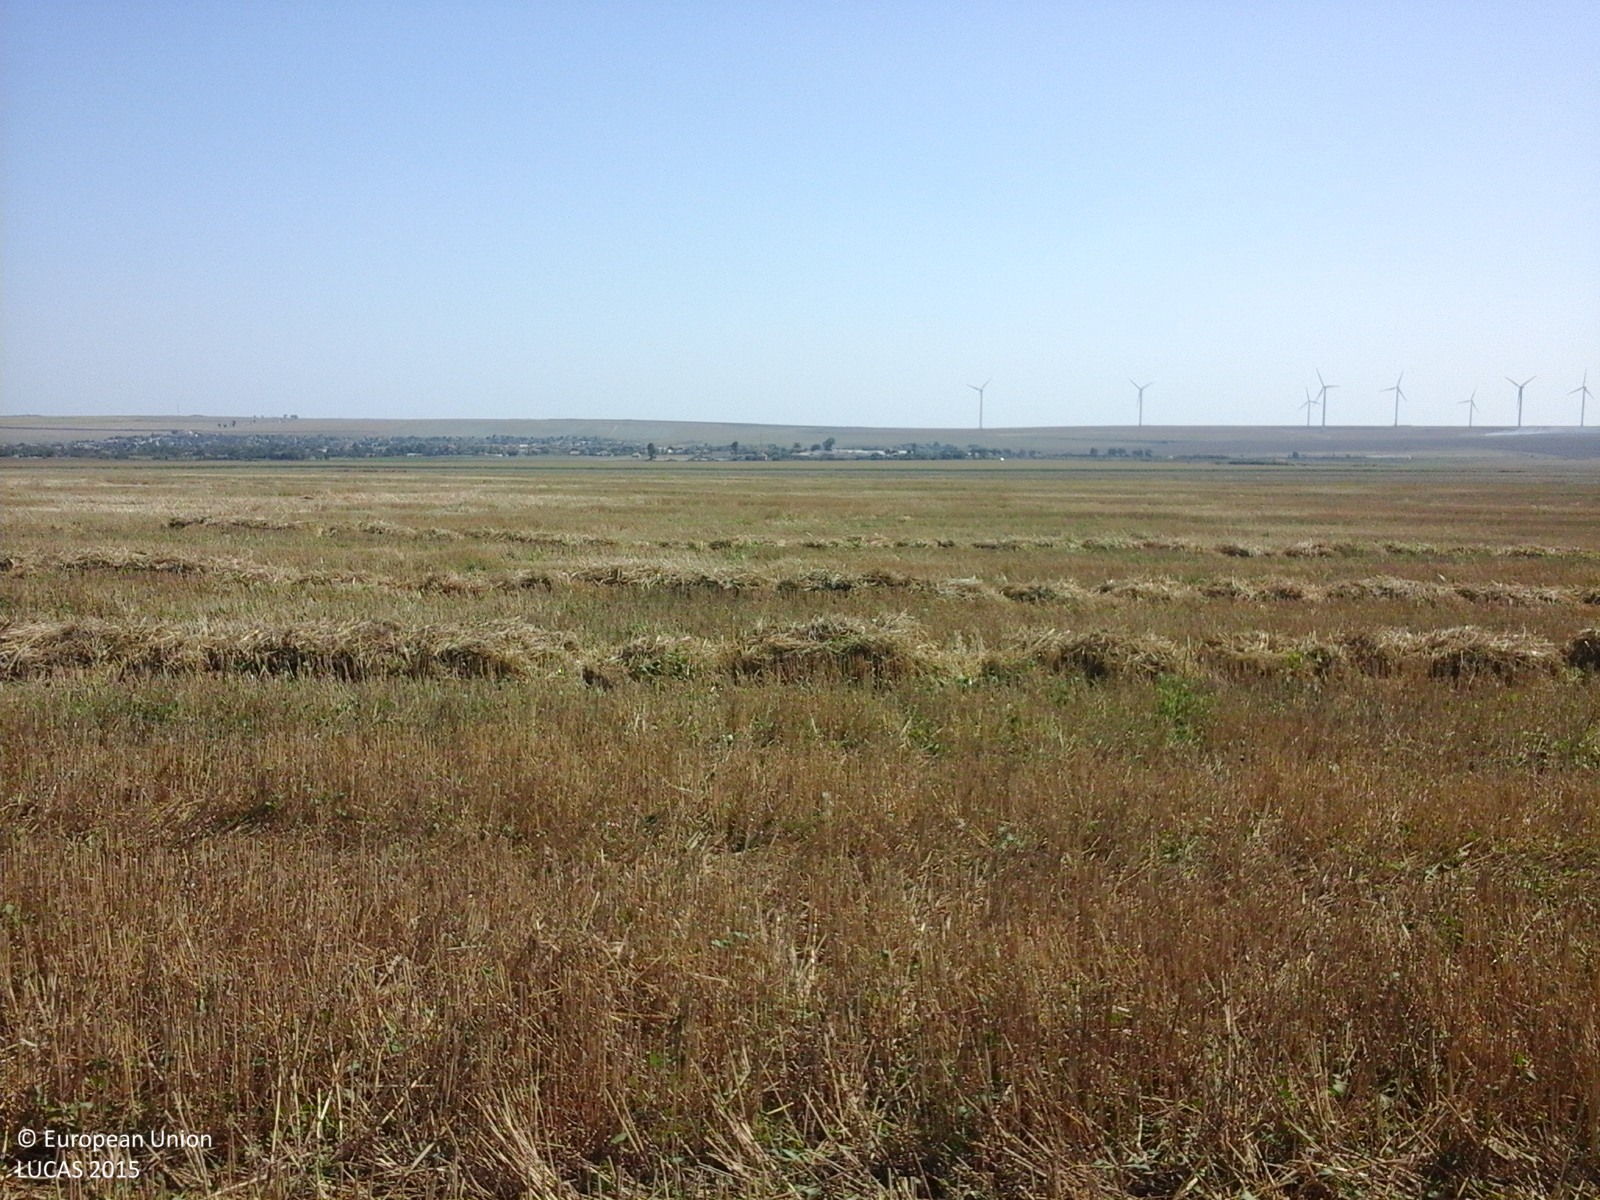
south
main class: Cropland
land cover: Common wheat
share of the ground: > 75 %
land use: Agriculture (excluding fallow land and kitchen gardens)
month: August
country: RO
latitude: 44.5804
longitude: 28.5515
